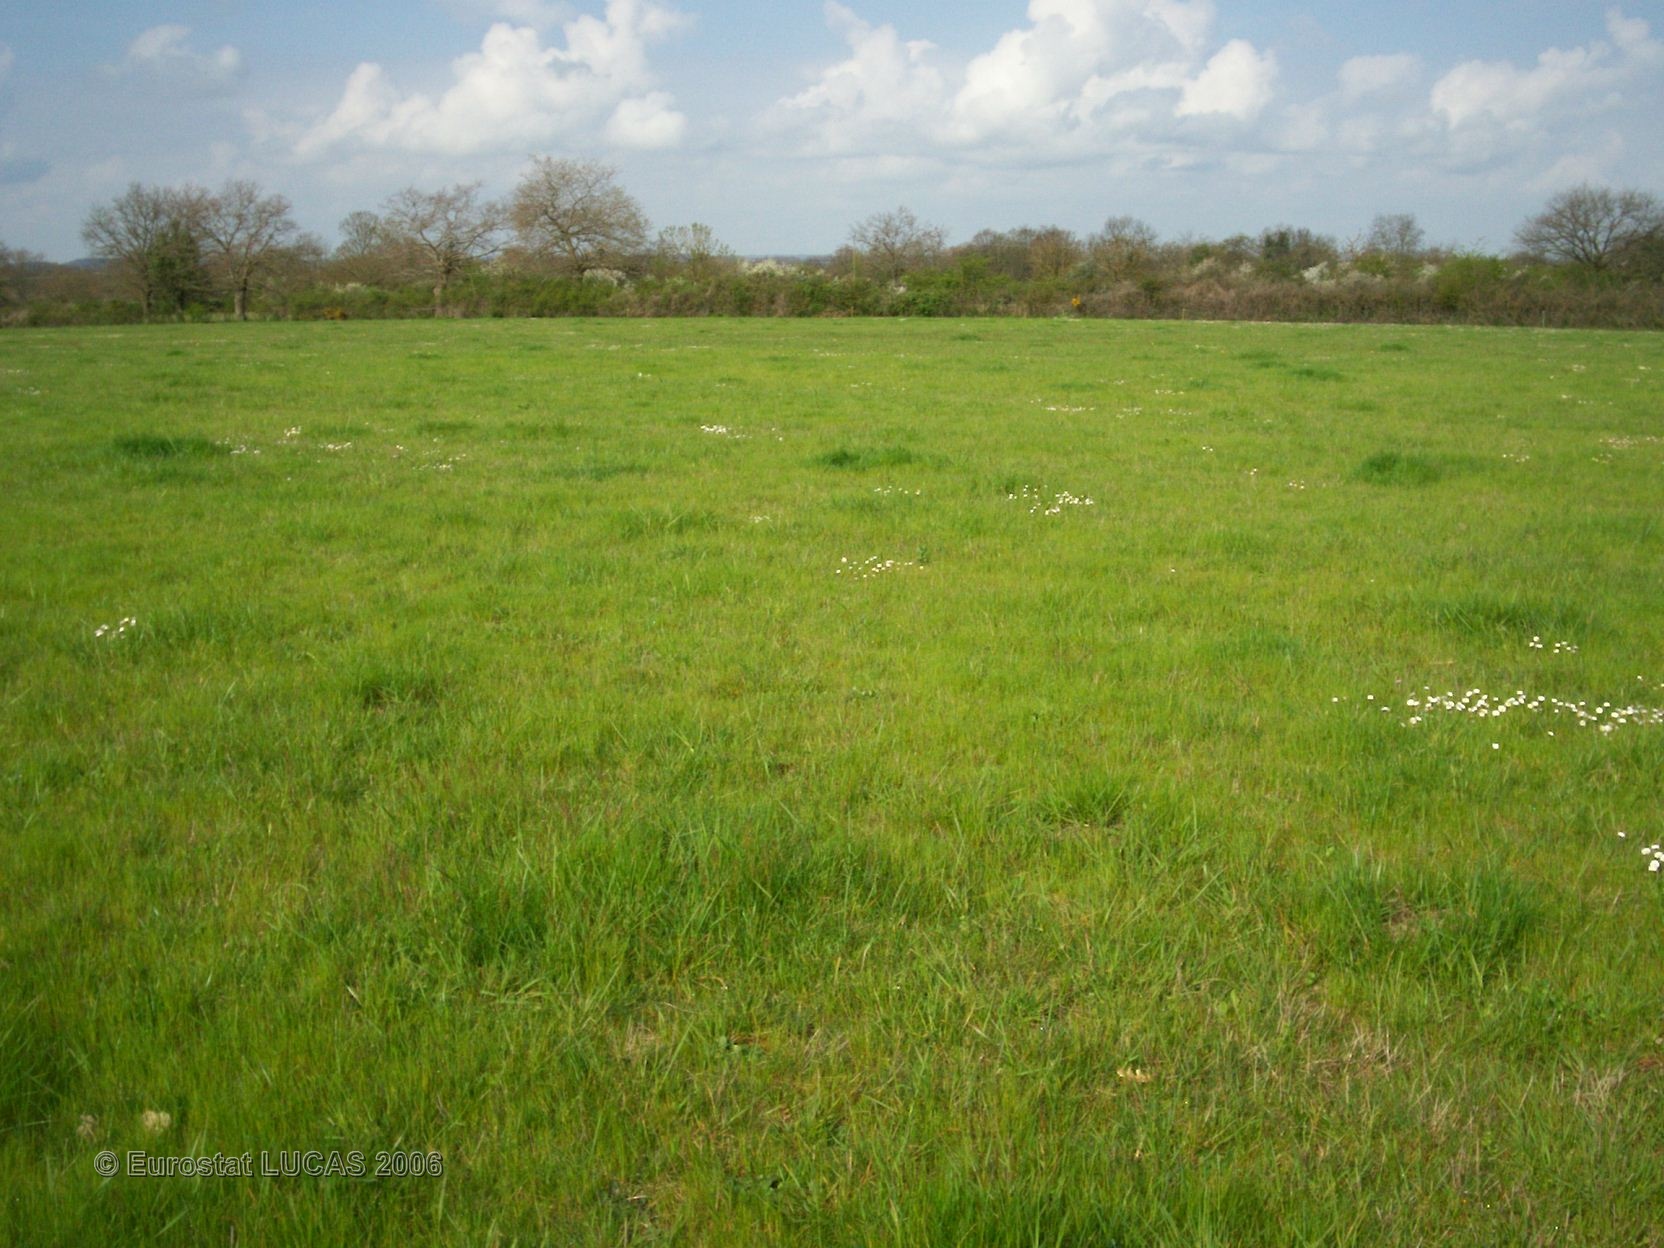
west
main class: Grassland
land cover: Grassland without tree/shrub cover
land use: Agriculture (excluding fallow land and kitchen gardens)
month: April
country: FR
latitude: 46.8794
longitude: -0.3801
